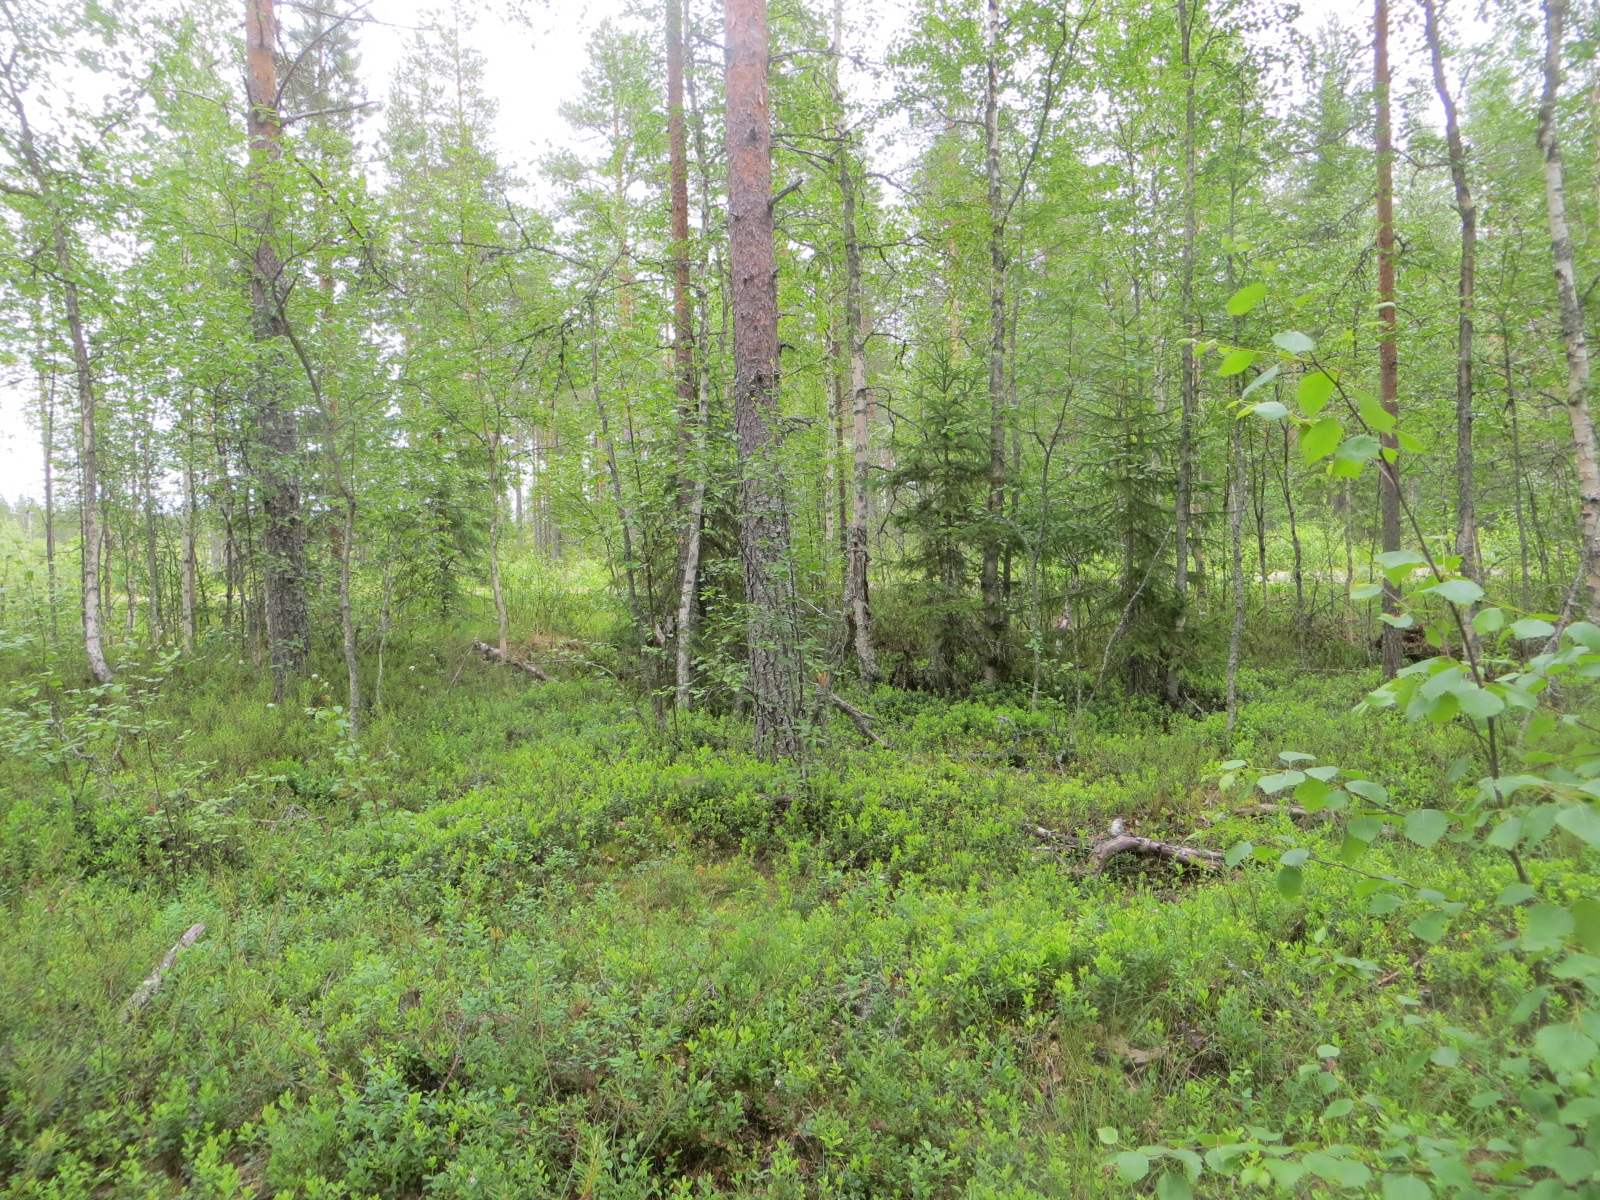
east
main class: Woodland
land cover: Pine dominated mixed woodland
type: boreal forest
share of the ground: 50 - 75 %
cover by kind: coniferous forest trees 50 %, shrubs 30 %, broadleaved forest trees 20 %
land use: Forestry
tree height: > 5 m
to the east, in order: Pine dominated mixed woodland; Ditches and canals; Abandoned hedges; Tracks; Abandoned hedges; Ditches and canals; Pine dominated coniferous woodland; Pine dominated mixed woodland; Broadleaved woodland
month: July
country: FI
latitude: 65.4726
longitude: 25.9559
